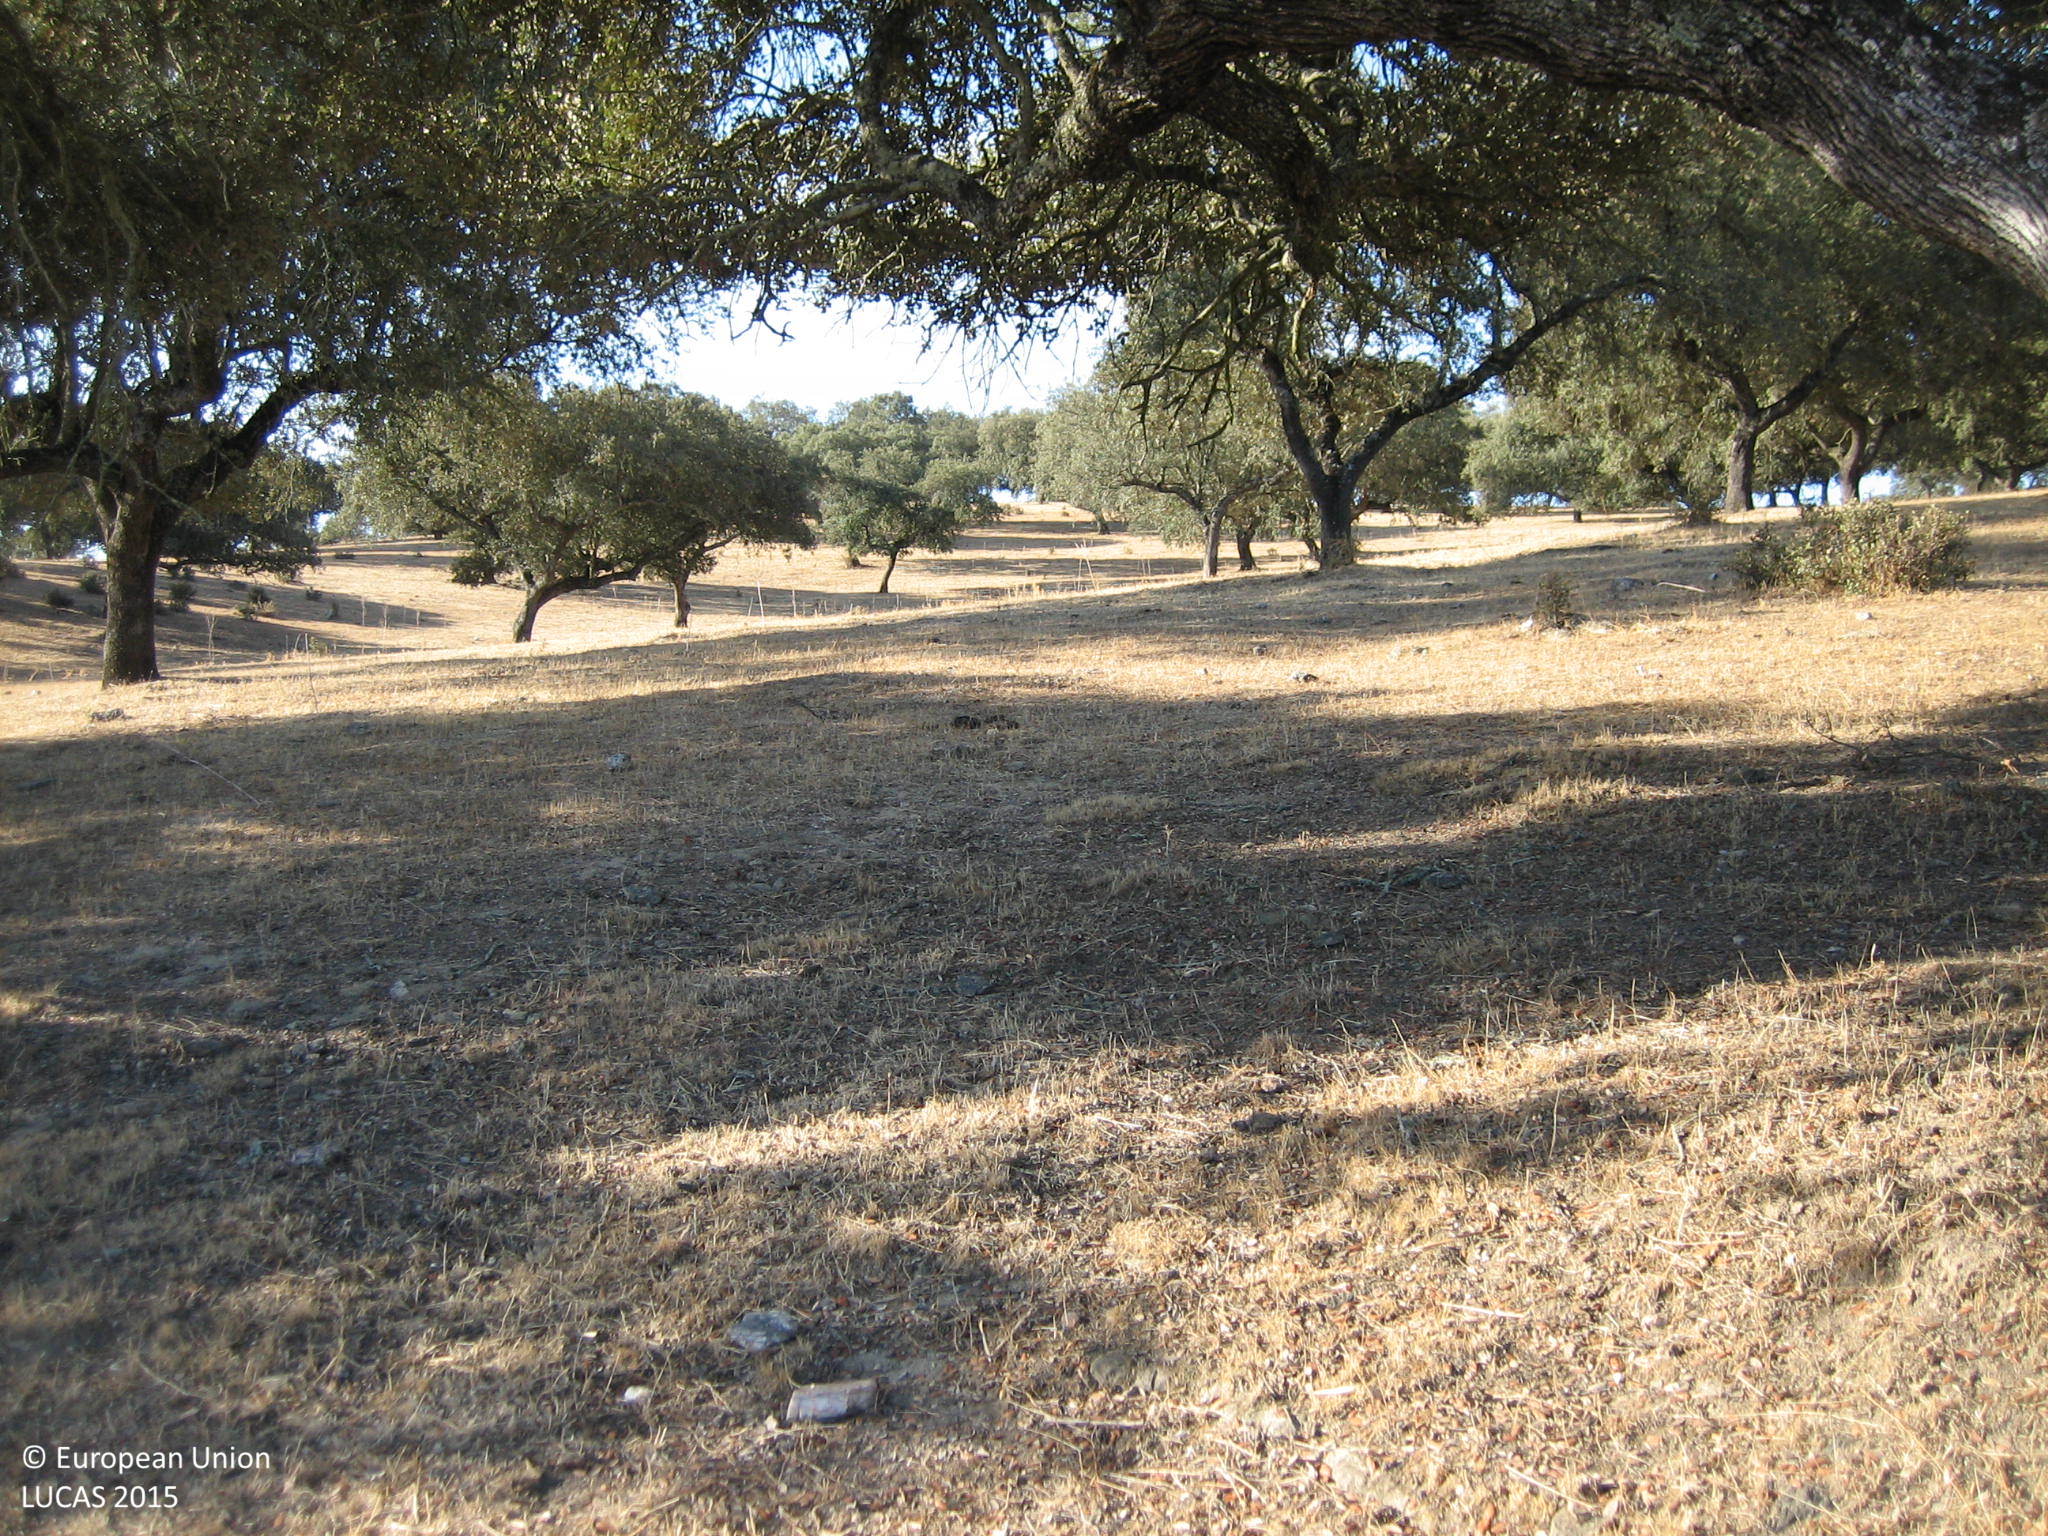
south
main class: Woodland
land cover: Broadleaved woodland
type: broadleaved evergreen forest
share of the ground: 25 - 50 %
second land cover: Grassland without tree/shrub cover
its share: 25 - 50 %
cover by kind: broadleaved forest trees 40 %, herbaceous plants 30 %, unconsolidated bare surface 30 %
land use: Forestry
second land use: Agriculture (excluding fallow land and kitchen gardens)
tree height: > 5 m
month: August
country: ES
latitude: 38.5725
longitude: -7.1823
